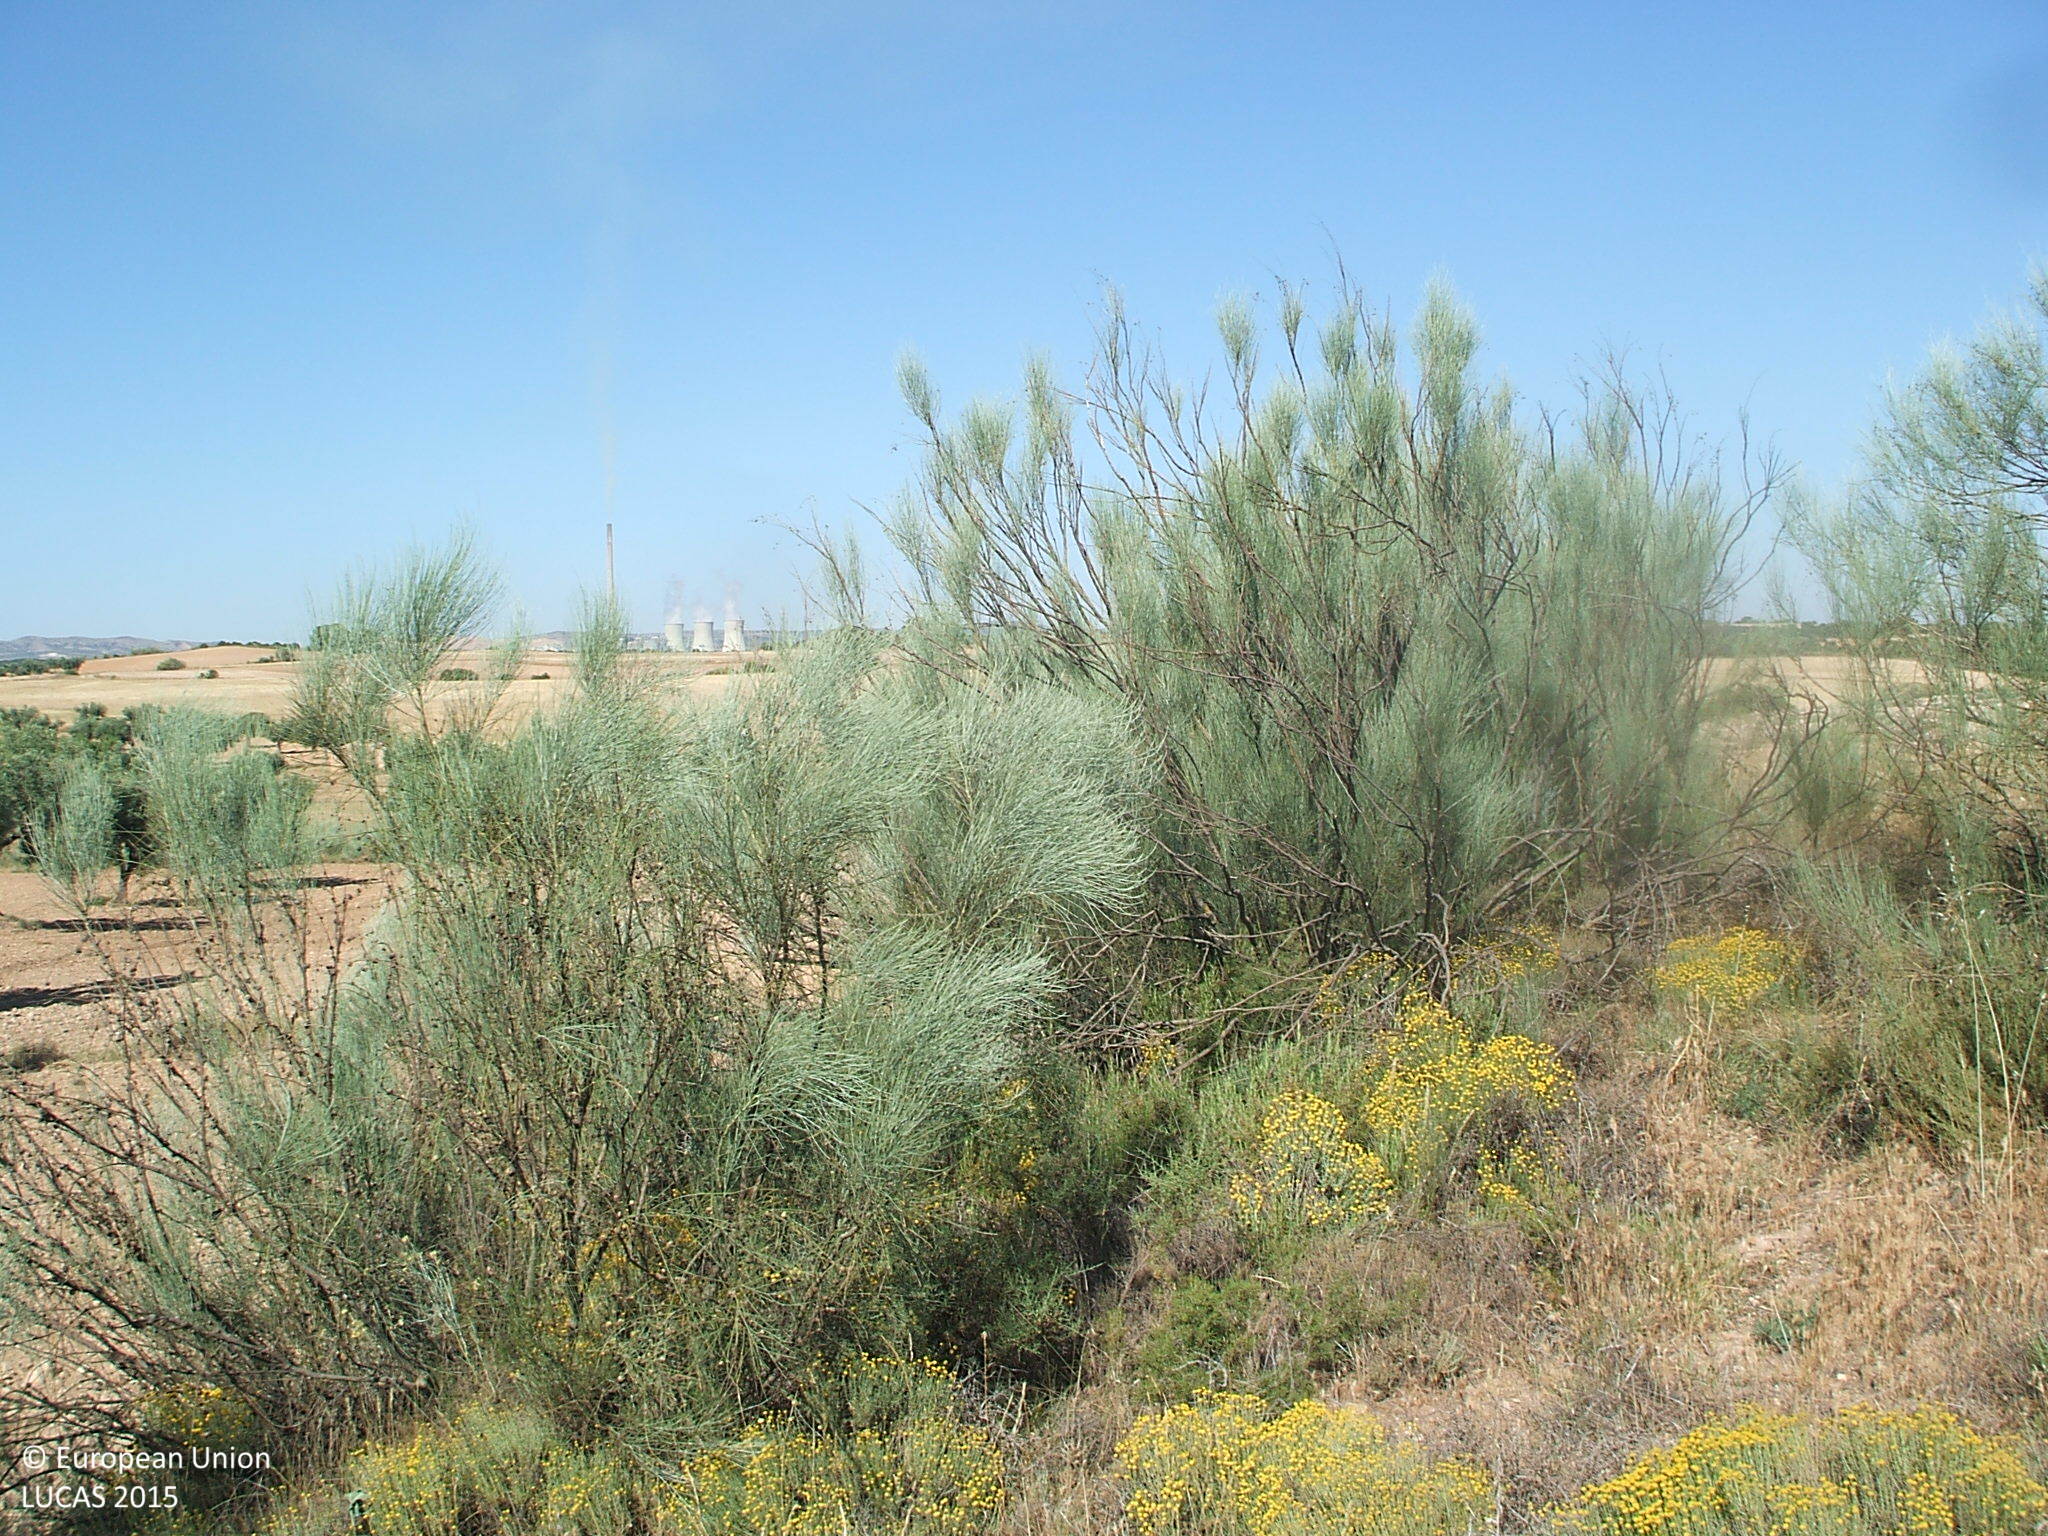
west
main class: Cropland
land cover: Olive groves
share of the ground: 10 - 25 %
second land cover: Other bare soil
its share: > 75 %
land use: Agriculture (excluding fallow land and kitchen gardens)
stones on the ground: > 50 %
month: June
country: ES
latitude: 41.0150
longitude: -0.3218
